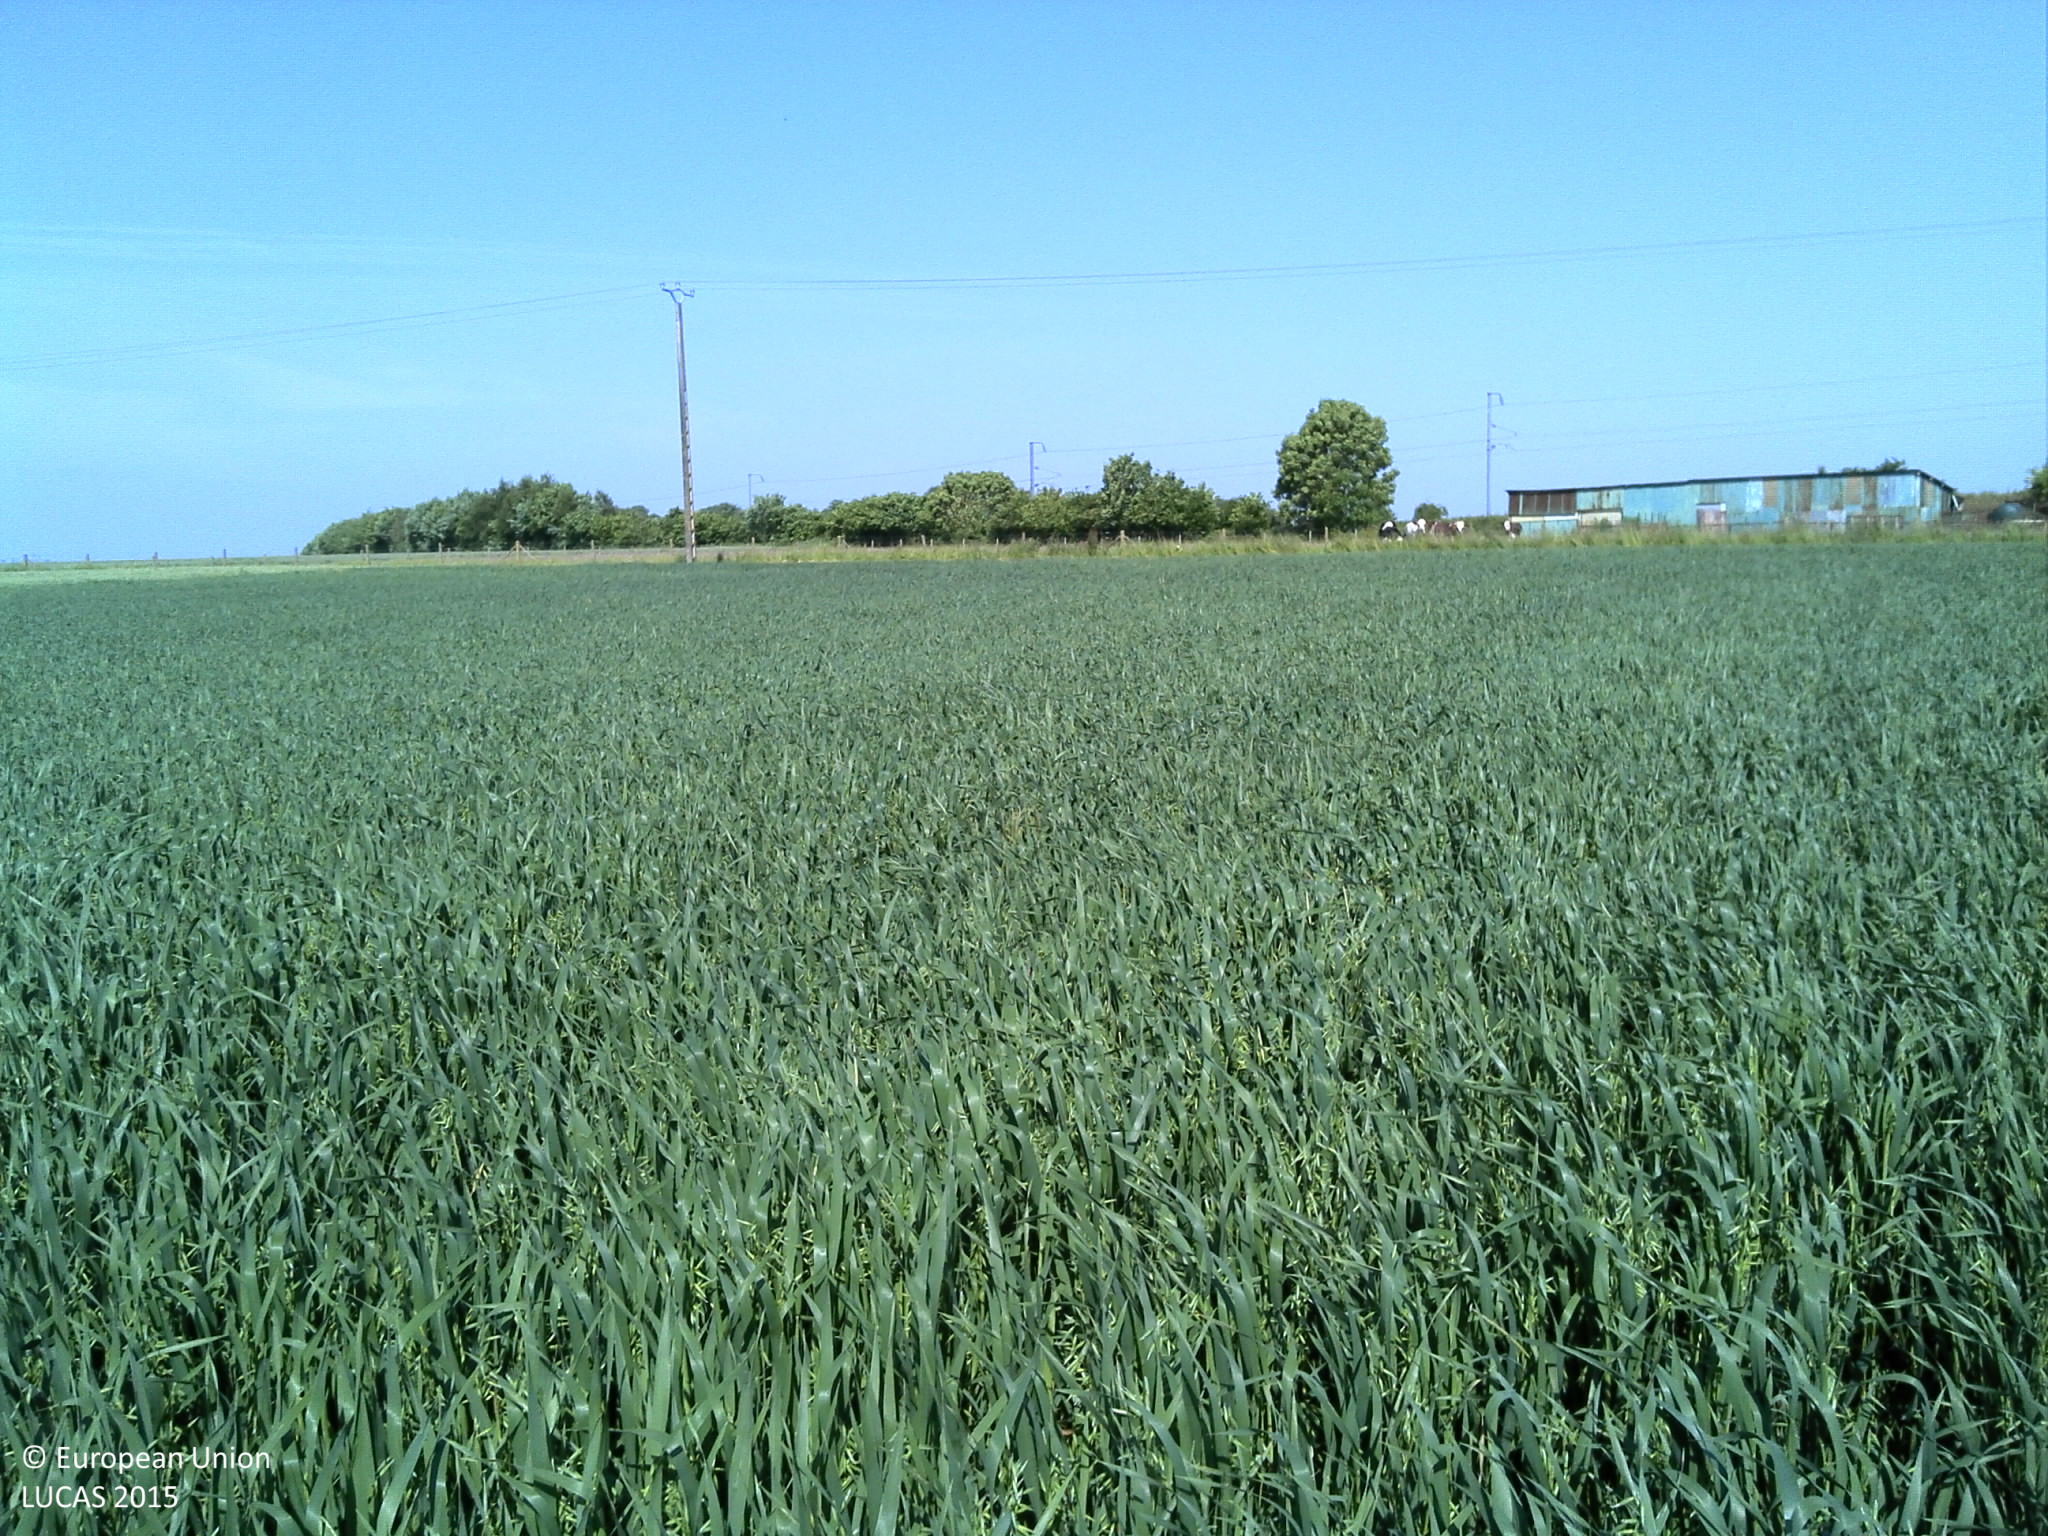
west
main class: Cropland
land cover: Oats
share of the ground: > 75 %
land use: Agriculture (excluding fallow land and kitchen gardens)
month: June
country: FR
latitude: 49.6346
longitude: 1.0751
